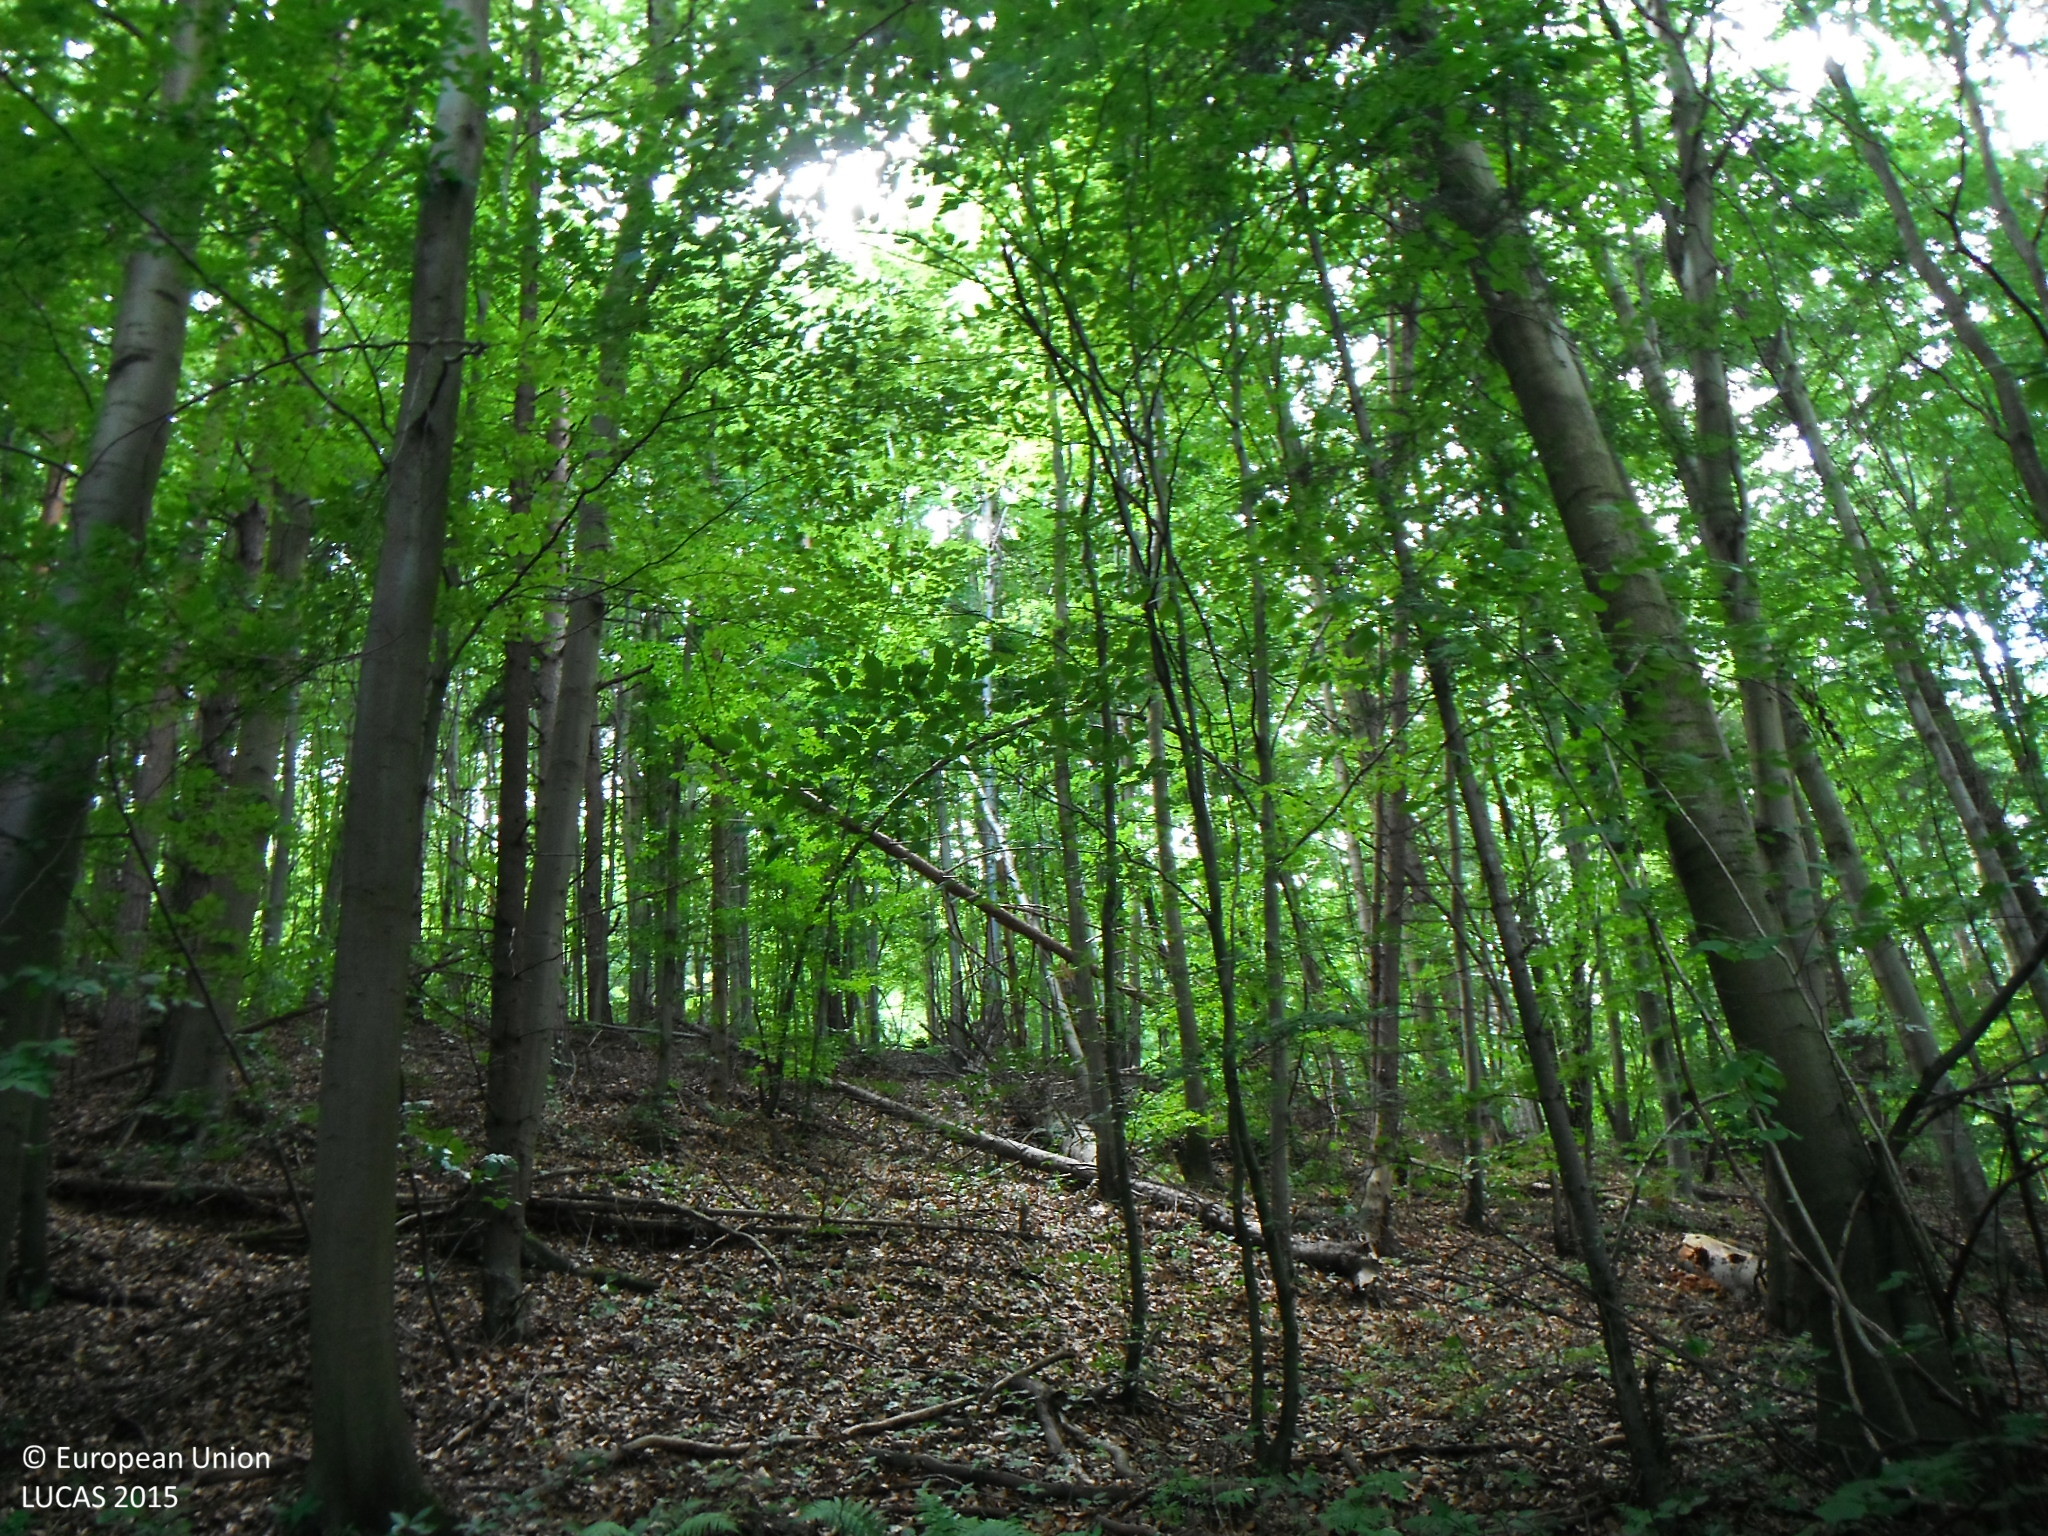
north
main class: Woodland
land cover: Other mixed woodland
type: hemiboreal forest and nemoral coniferous forest and mixed broadleaved-coniferous forest
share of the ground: > 75 %
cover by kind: broadleaved forest trees 60 %, coniferous forest trees 40 %
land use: Forestry
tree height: > 5 m
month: June
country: SK
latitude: 48.8982
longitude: 21.0783
